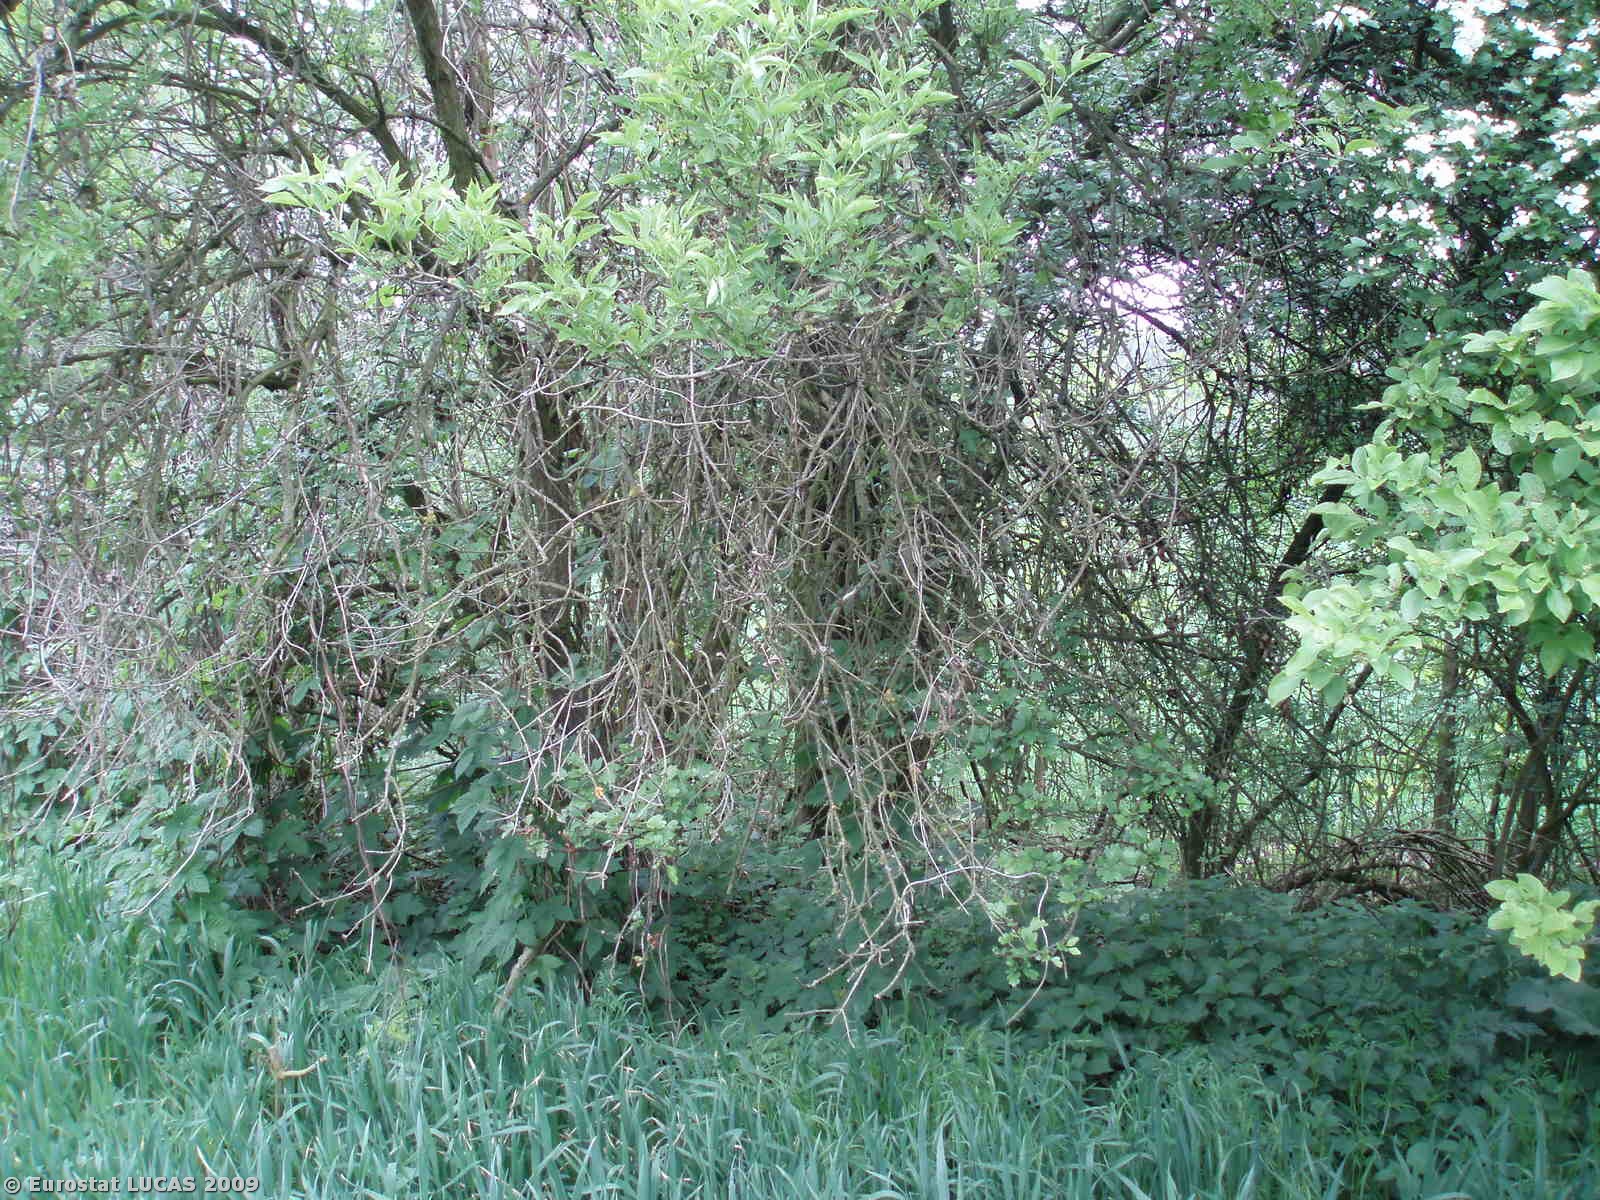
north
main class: Woodland
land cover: Broadleaved woodland
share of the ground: > 75 %
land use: Unused
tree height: > 5 m
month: May
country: CZ
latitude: 50.2163
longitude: 14.1634
